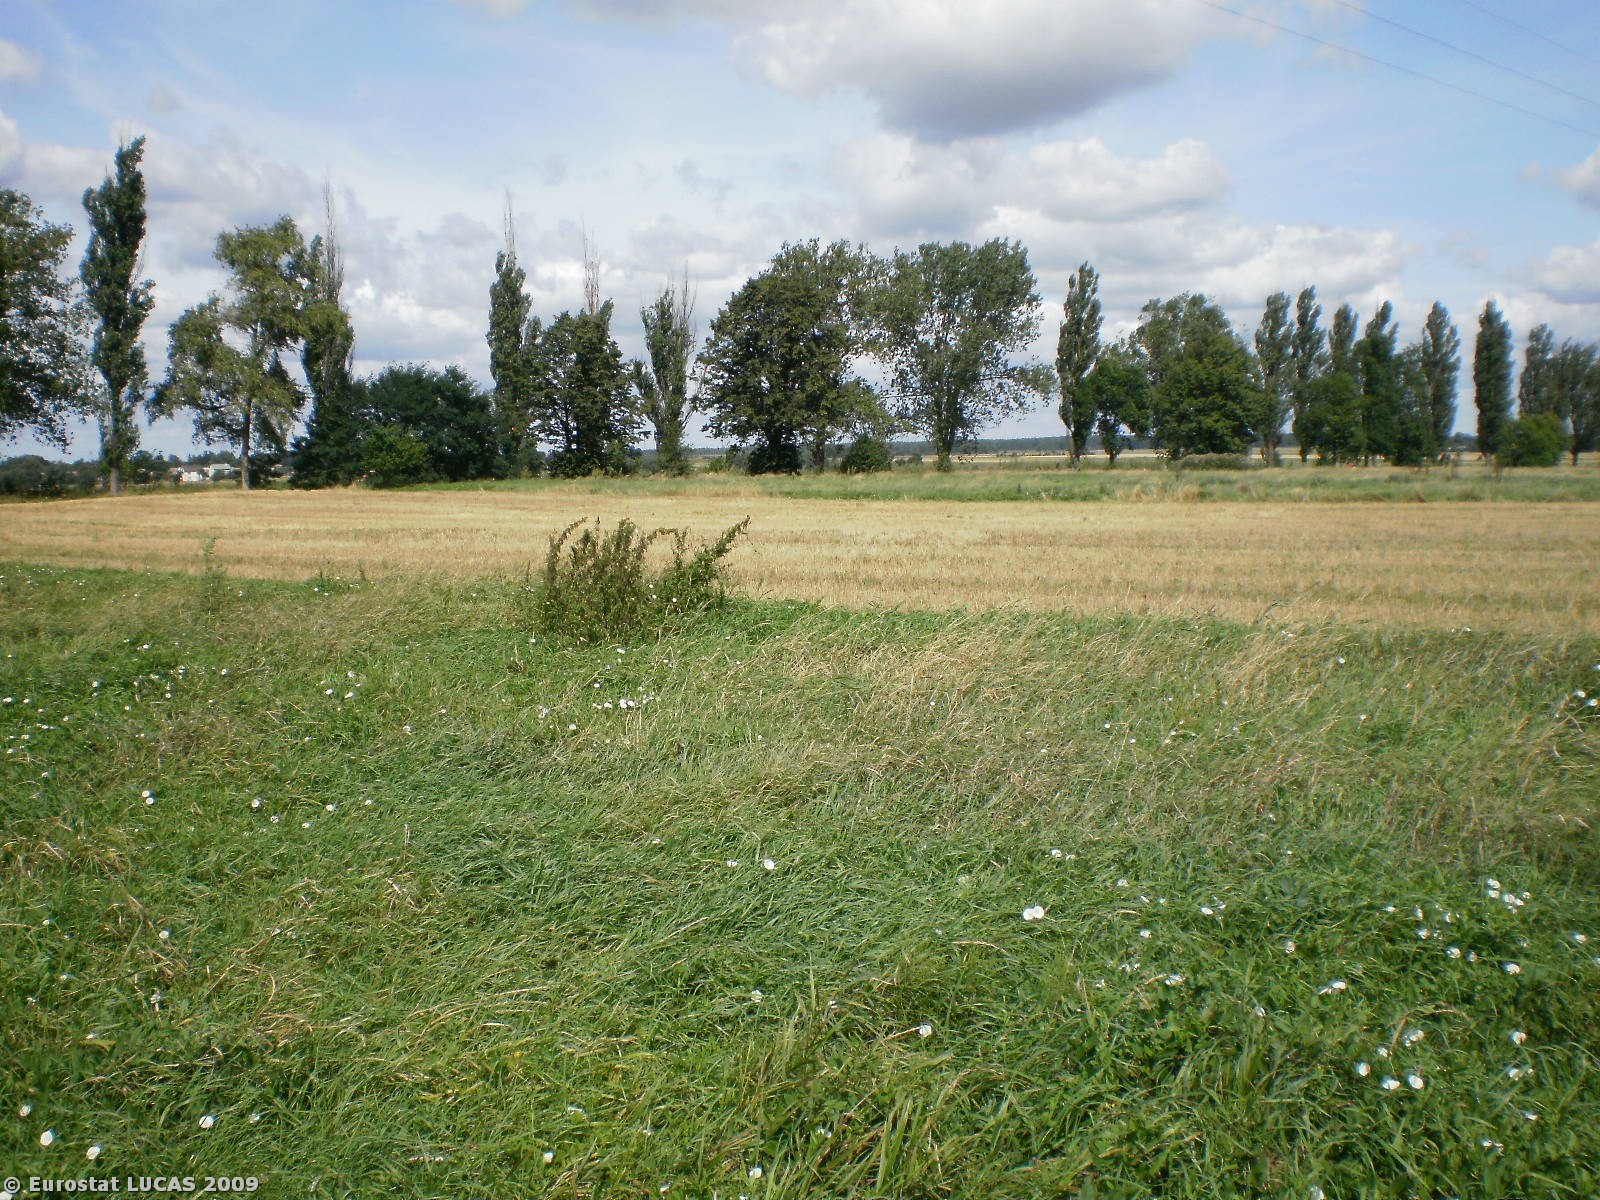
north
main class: Grassland
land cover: Grassland without tree/shrub cover
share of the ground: > 75 %
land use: Agriculture (excluding fallow land and kitchen gardens)
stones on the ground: < 10 %
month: August
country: PL
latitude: 52.5550
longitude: 22.1101
